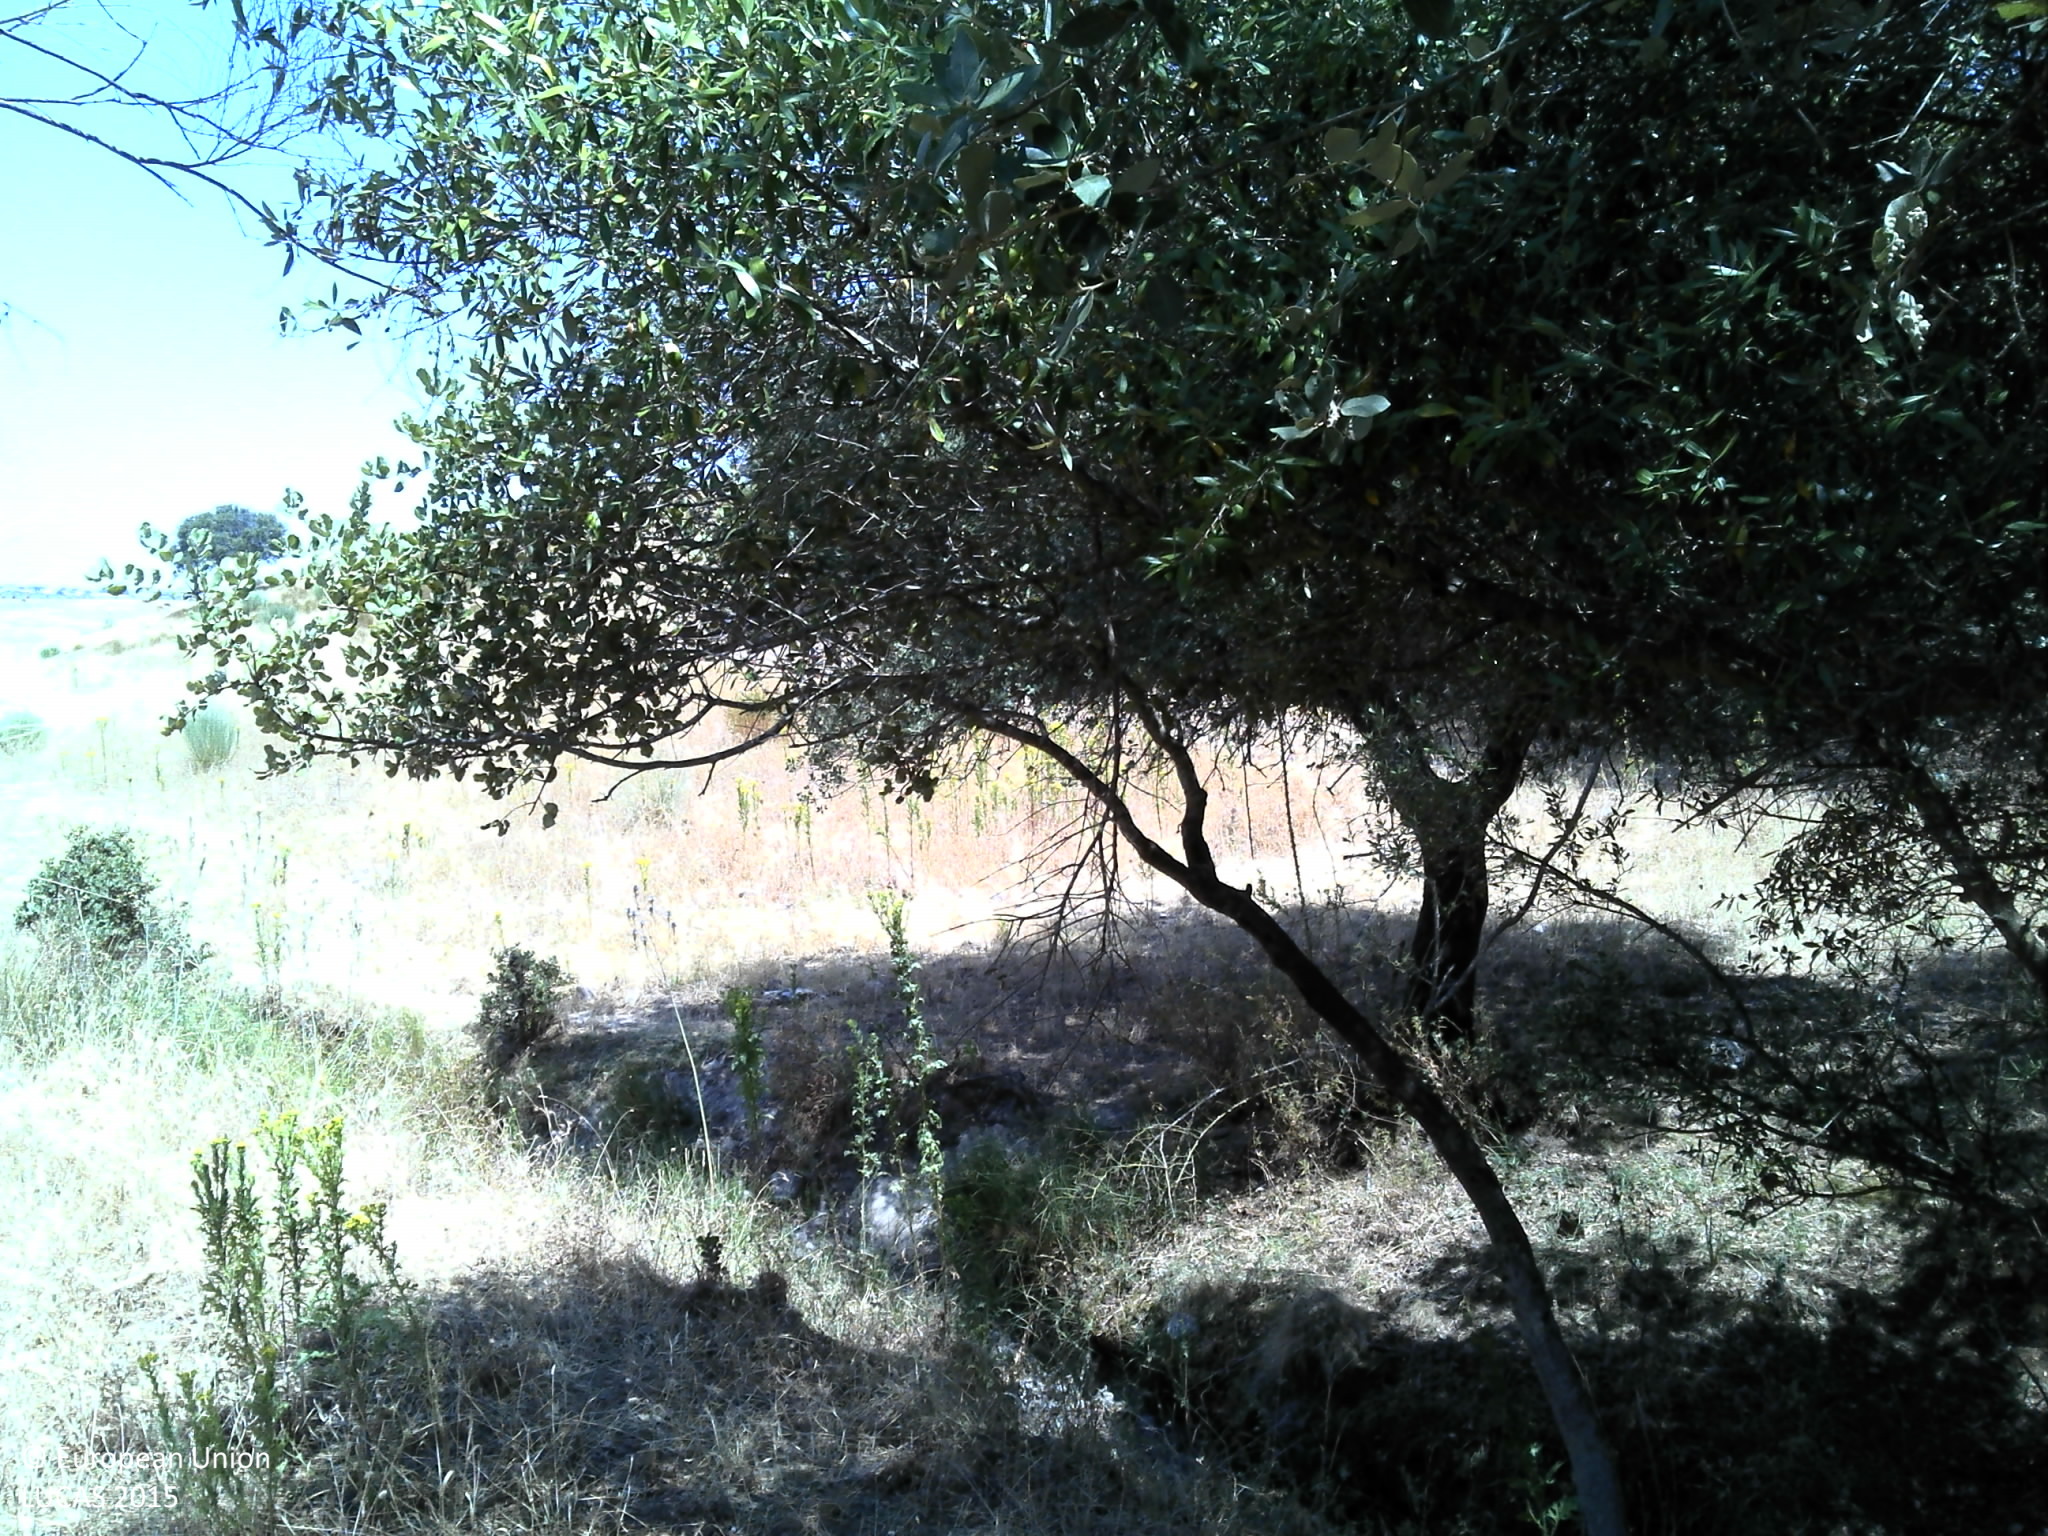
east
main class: Woodland
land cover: Broadleaved woodland
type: broadleaved evergreen forest
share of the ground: 50 - 75 %
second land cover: Grassland without tree/shrub cover
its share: 25 - 50 %
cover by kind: broadleaved forest trees 50 %, herbaceous plants 30 %, unconsolidated bare surface 20 %
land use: Forestry
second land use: Agriculture (excluding fallow land and kitchen gardens)
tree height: > 5 m
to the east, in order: Broadleaved woodland; Grassland without tree/shrub cover; Fences; Broadleaved woodland; Rivers and streams; Grassland without tree/shrub cover; Shrubland without tree cover
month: June
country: PT
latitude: 38.2105
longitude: -7.3450
